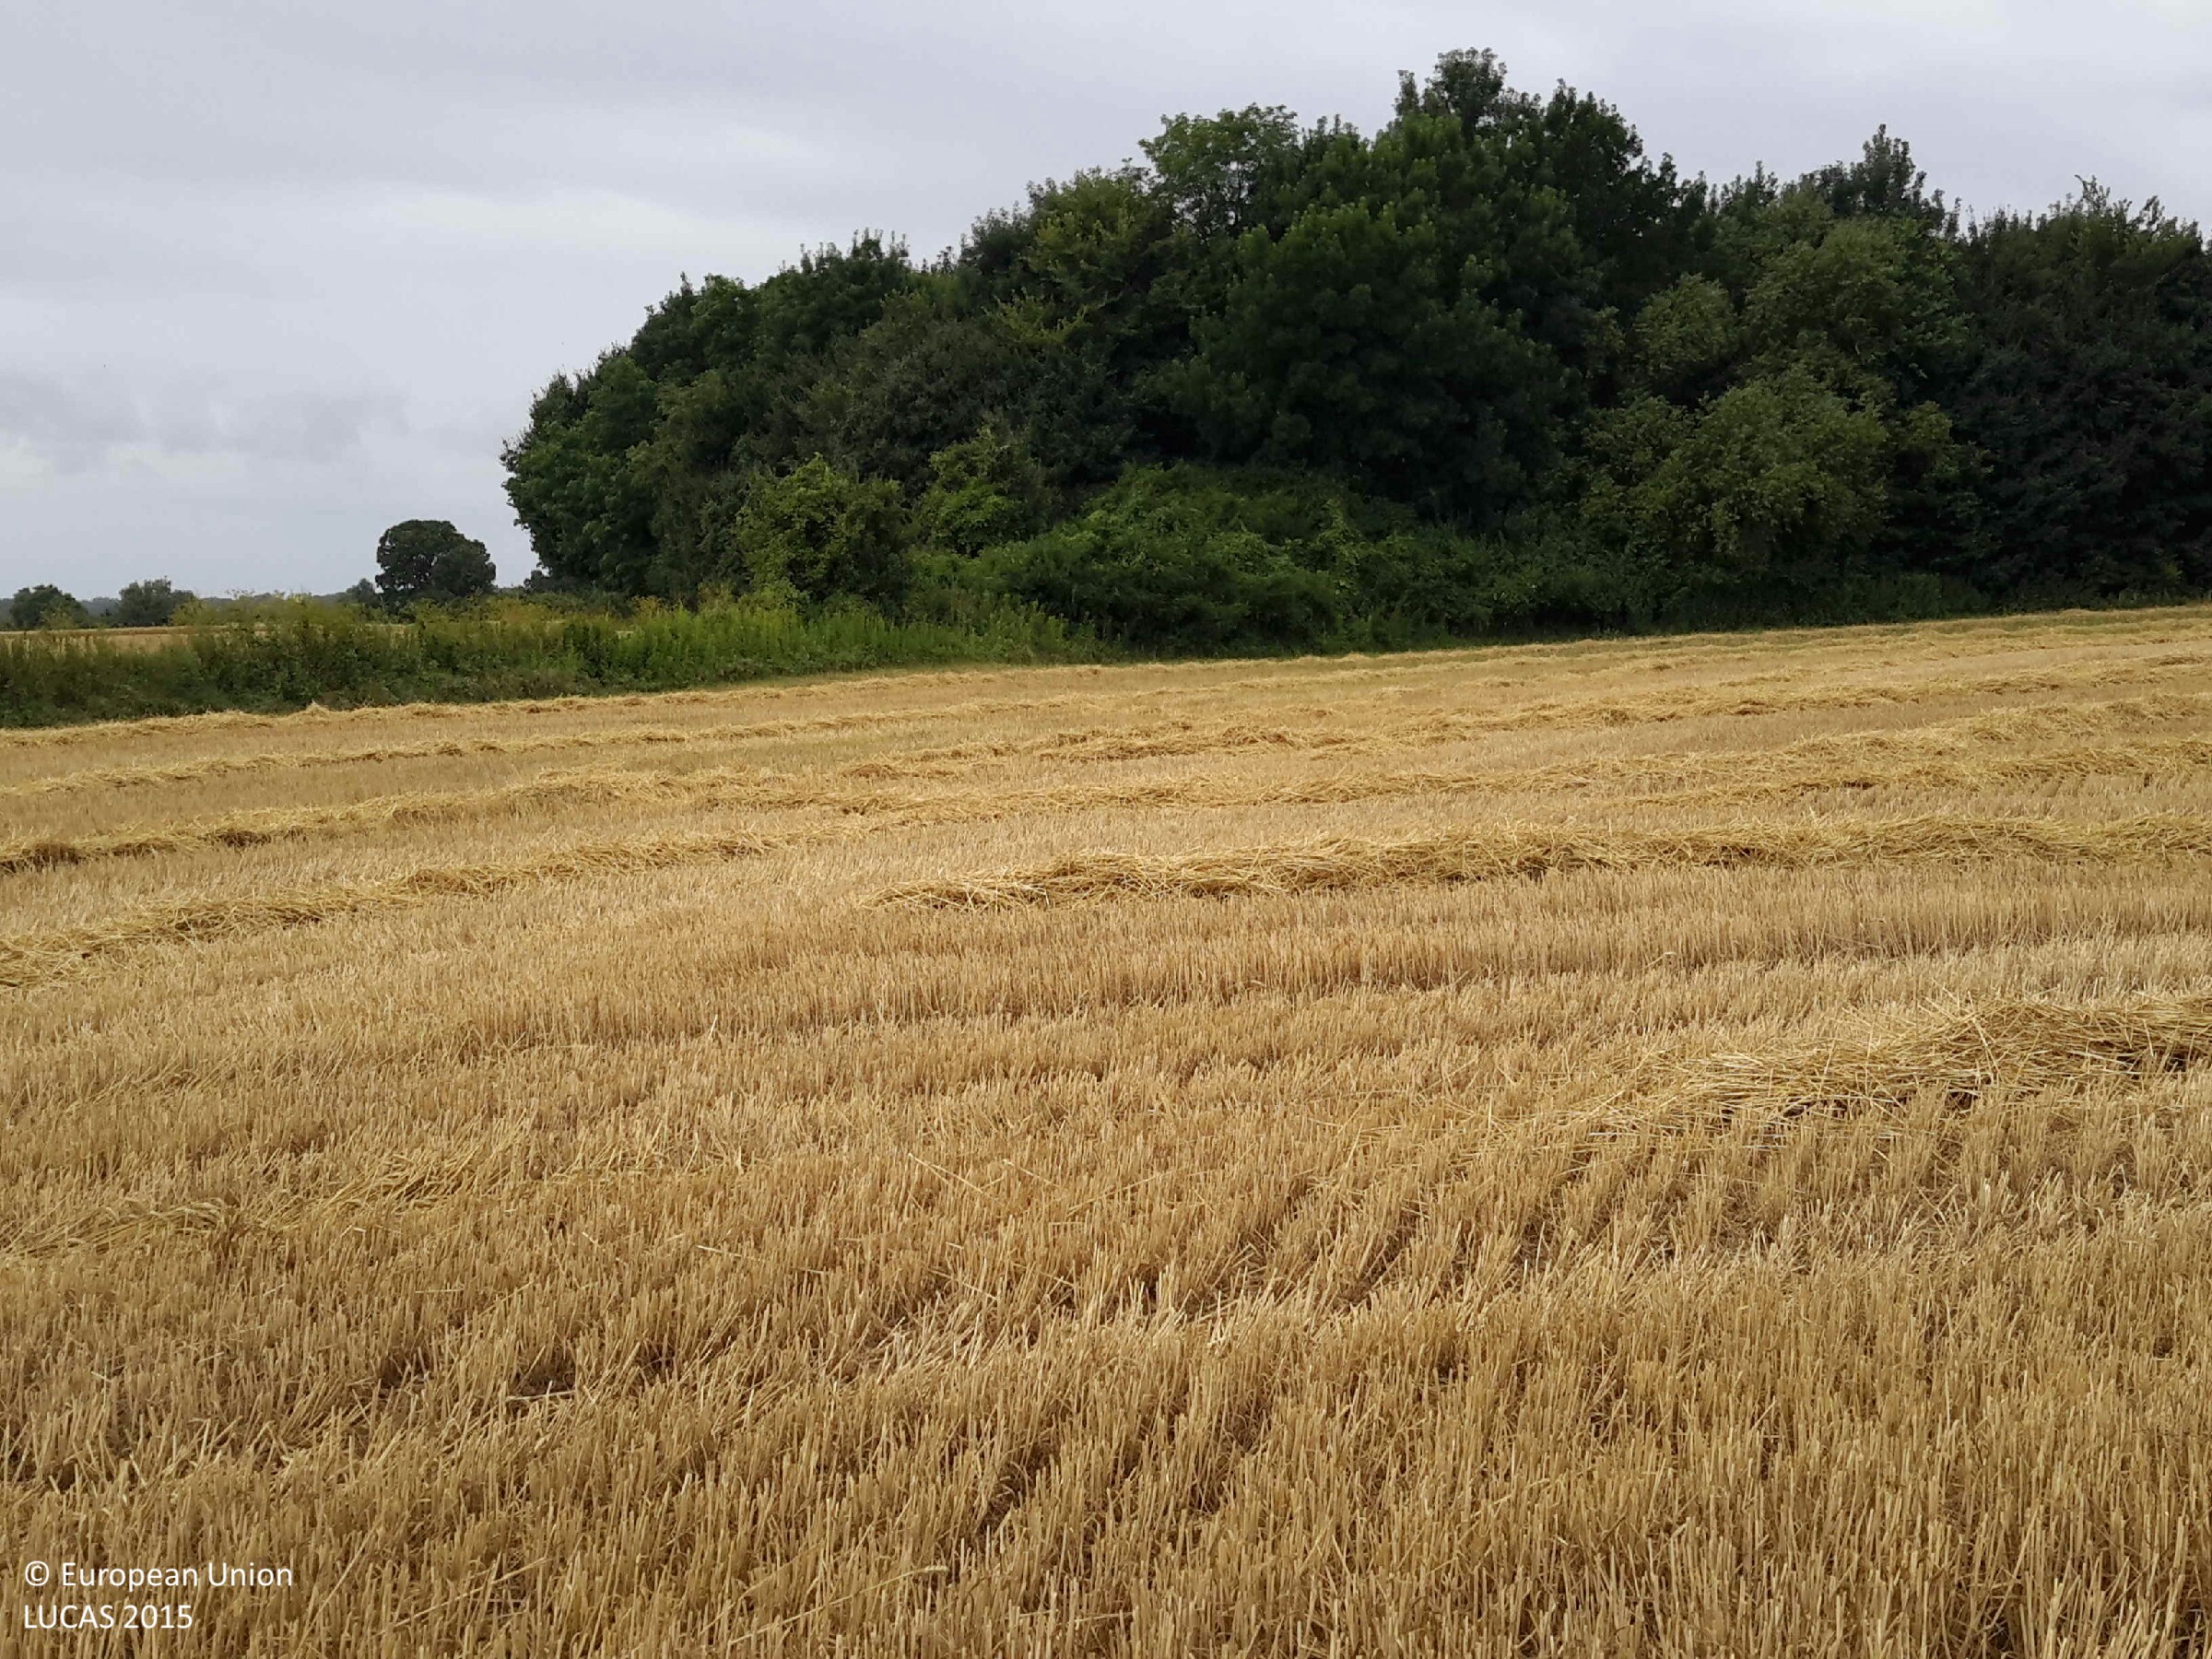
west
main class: Cropland
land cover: Common wheat
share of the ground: 50 - 75 %
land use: Agriculture (excluding fallow land and kitchen gardens)
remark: Harvested field
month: July
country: HU
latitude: 47.3825
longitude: 17.0657
